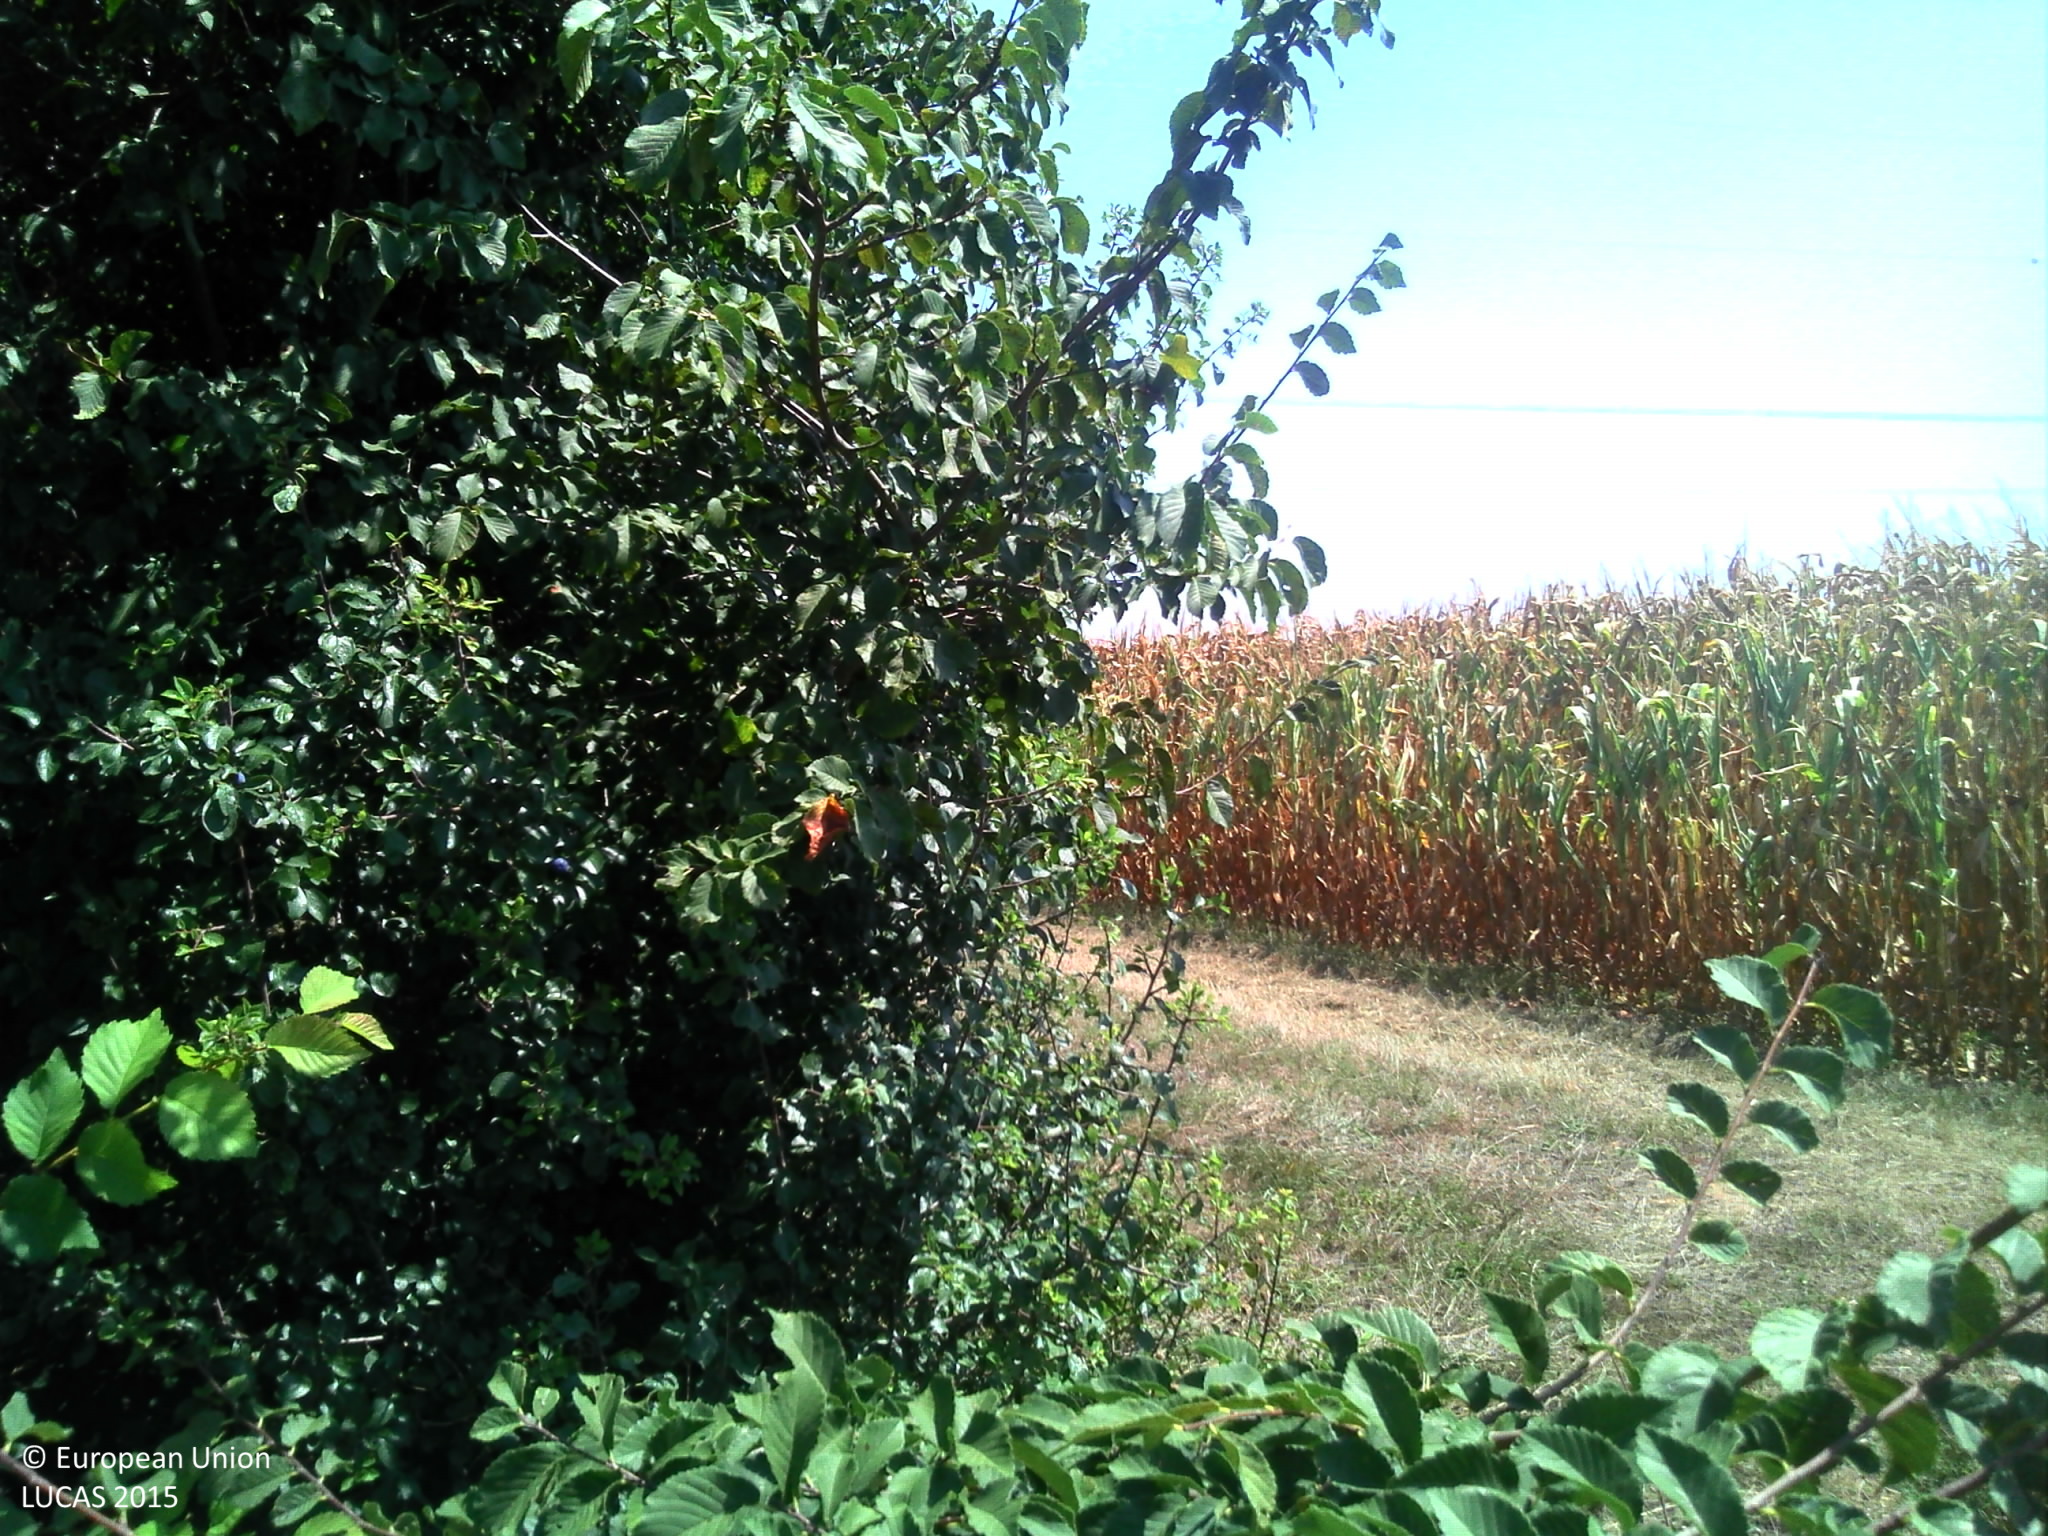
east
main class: Cropland
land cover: Maize
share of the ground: > 75 %
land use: Agriculture (excluding fallow land and kitchen gardens)
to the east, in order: Maize; Abandoned hedges; Fences; Tracks; Maize; Electric lines; Maize; Grass margins; Tracks; Grass margins
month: August
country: FR
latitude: 45.7172
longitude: 5.1349
